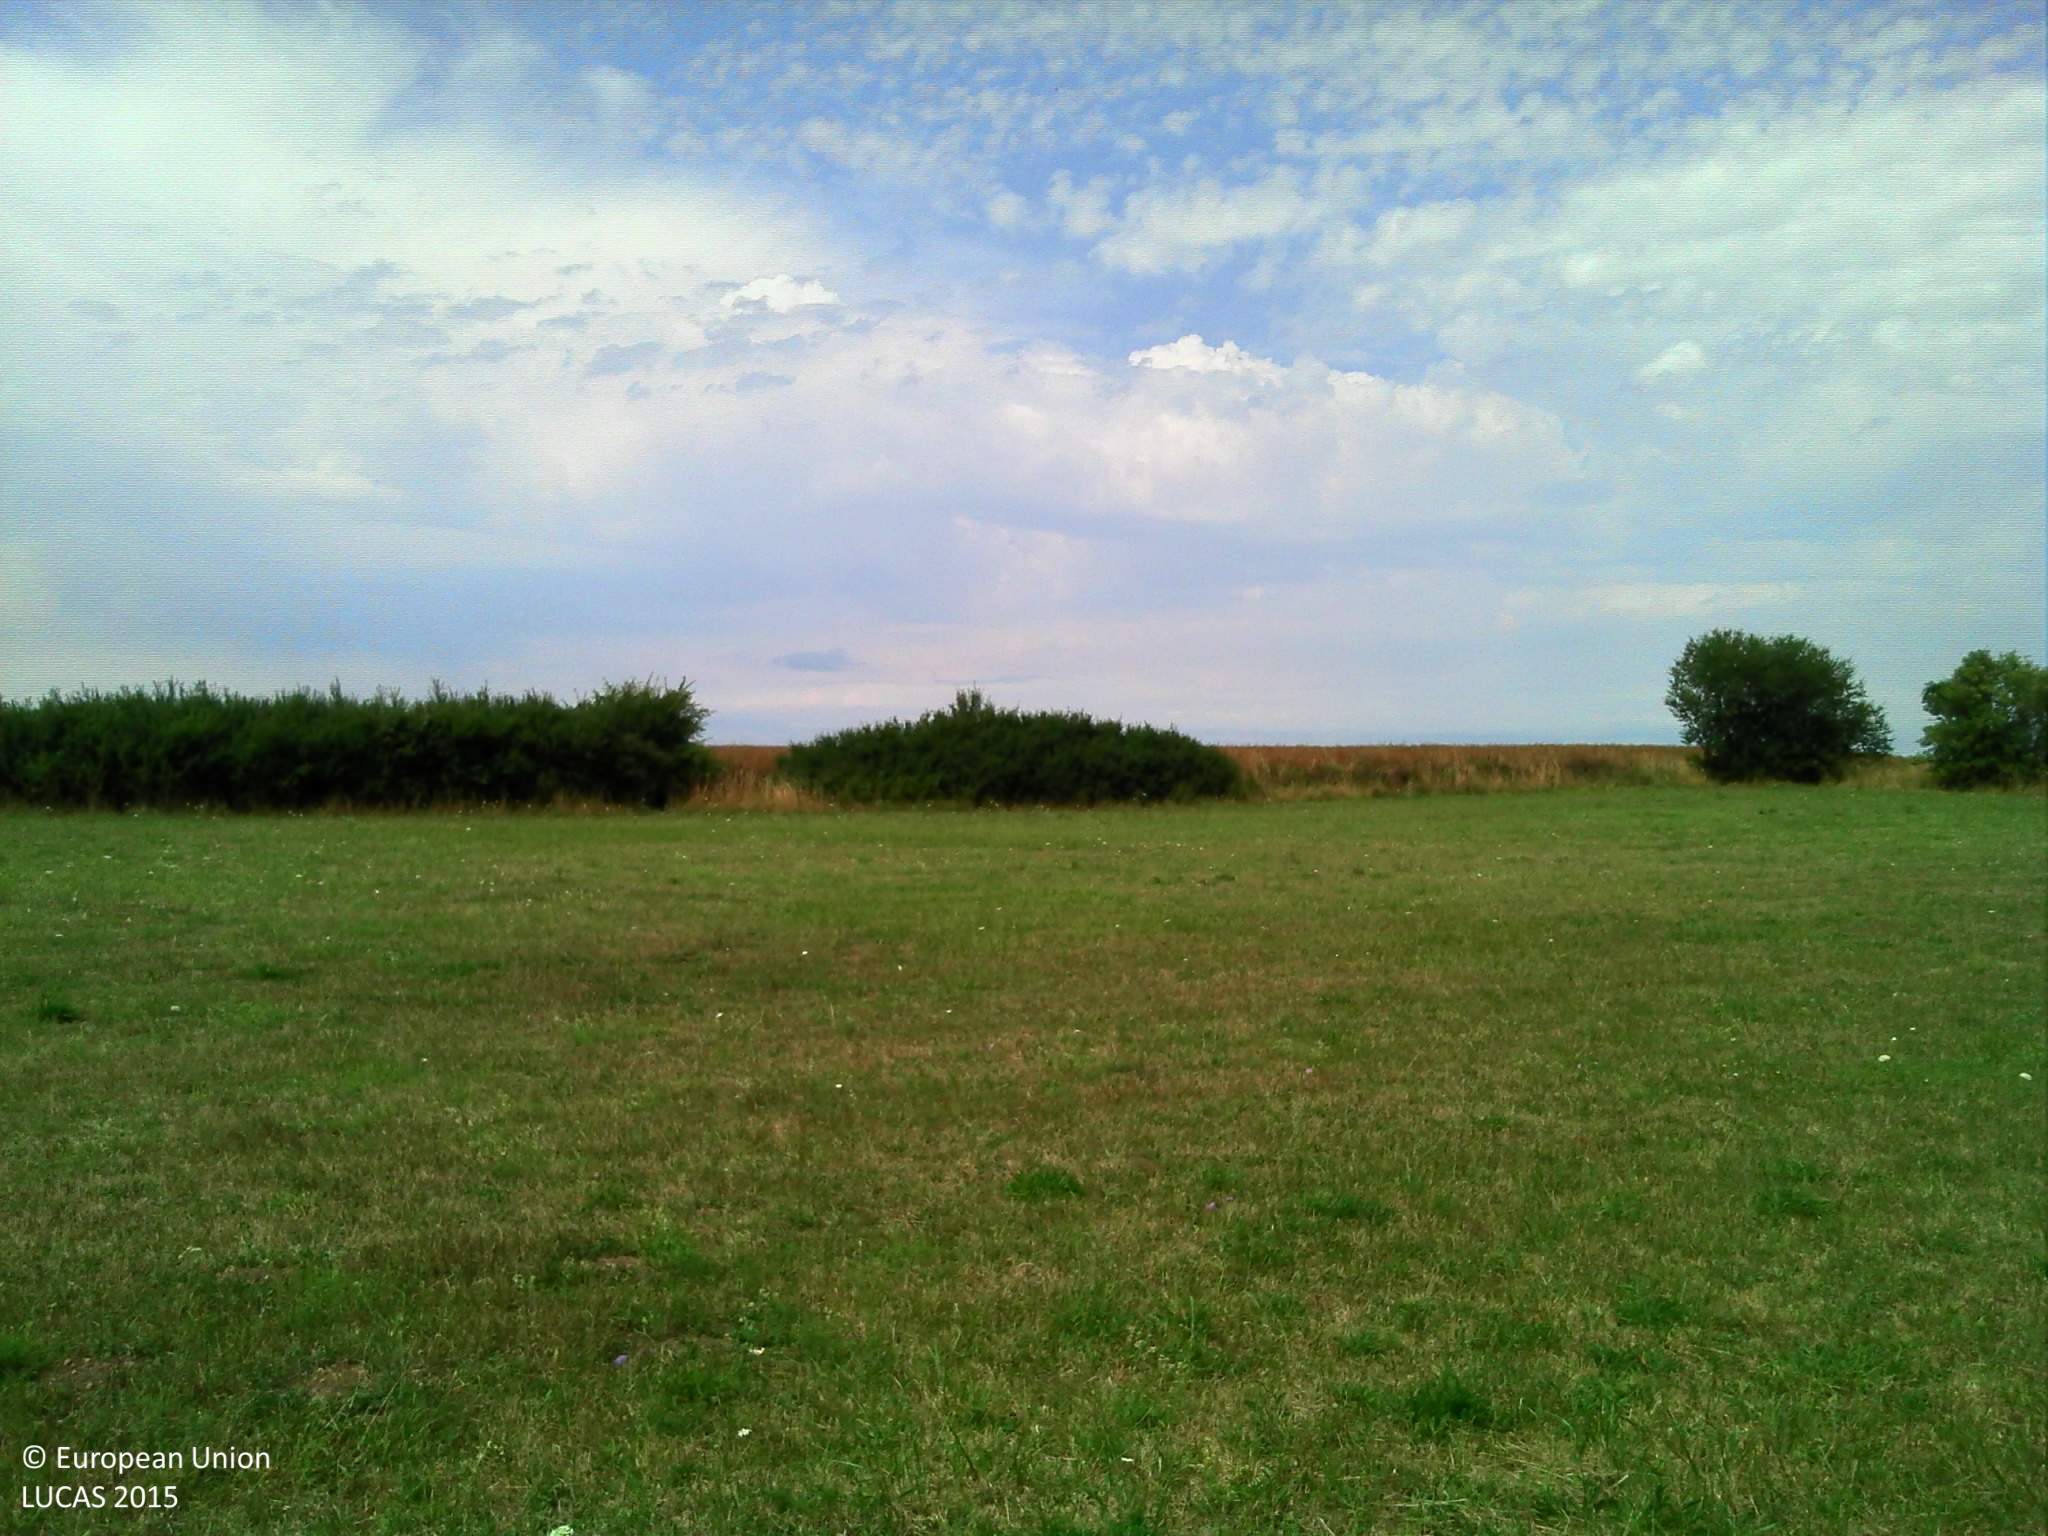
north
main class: Grassland
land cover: Grassland without tree/shrub cover
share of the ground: > 75 %
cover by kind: herbaceous plants 100 %
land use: Agriculture (excluding fallow land and kitchen gardens)
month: July
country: FR
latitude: 49.0726
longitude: -0.2037
